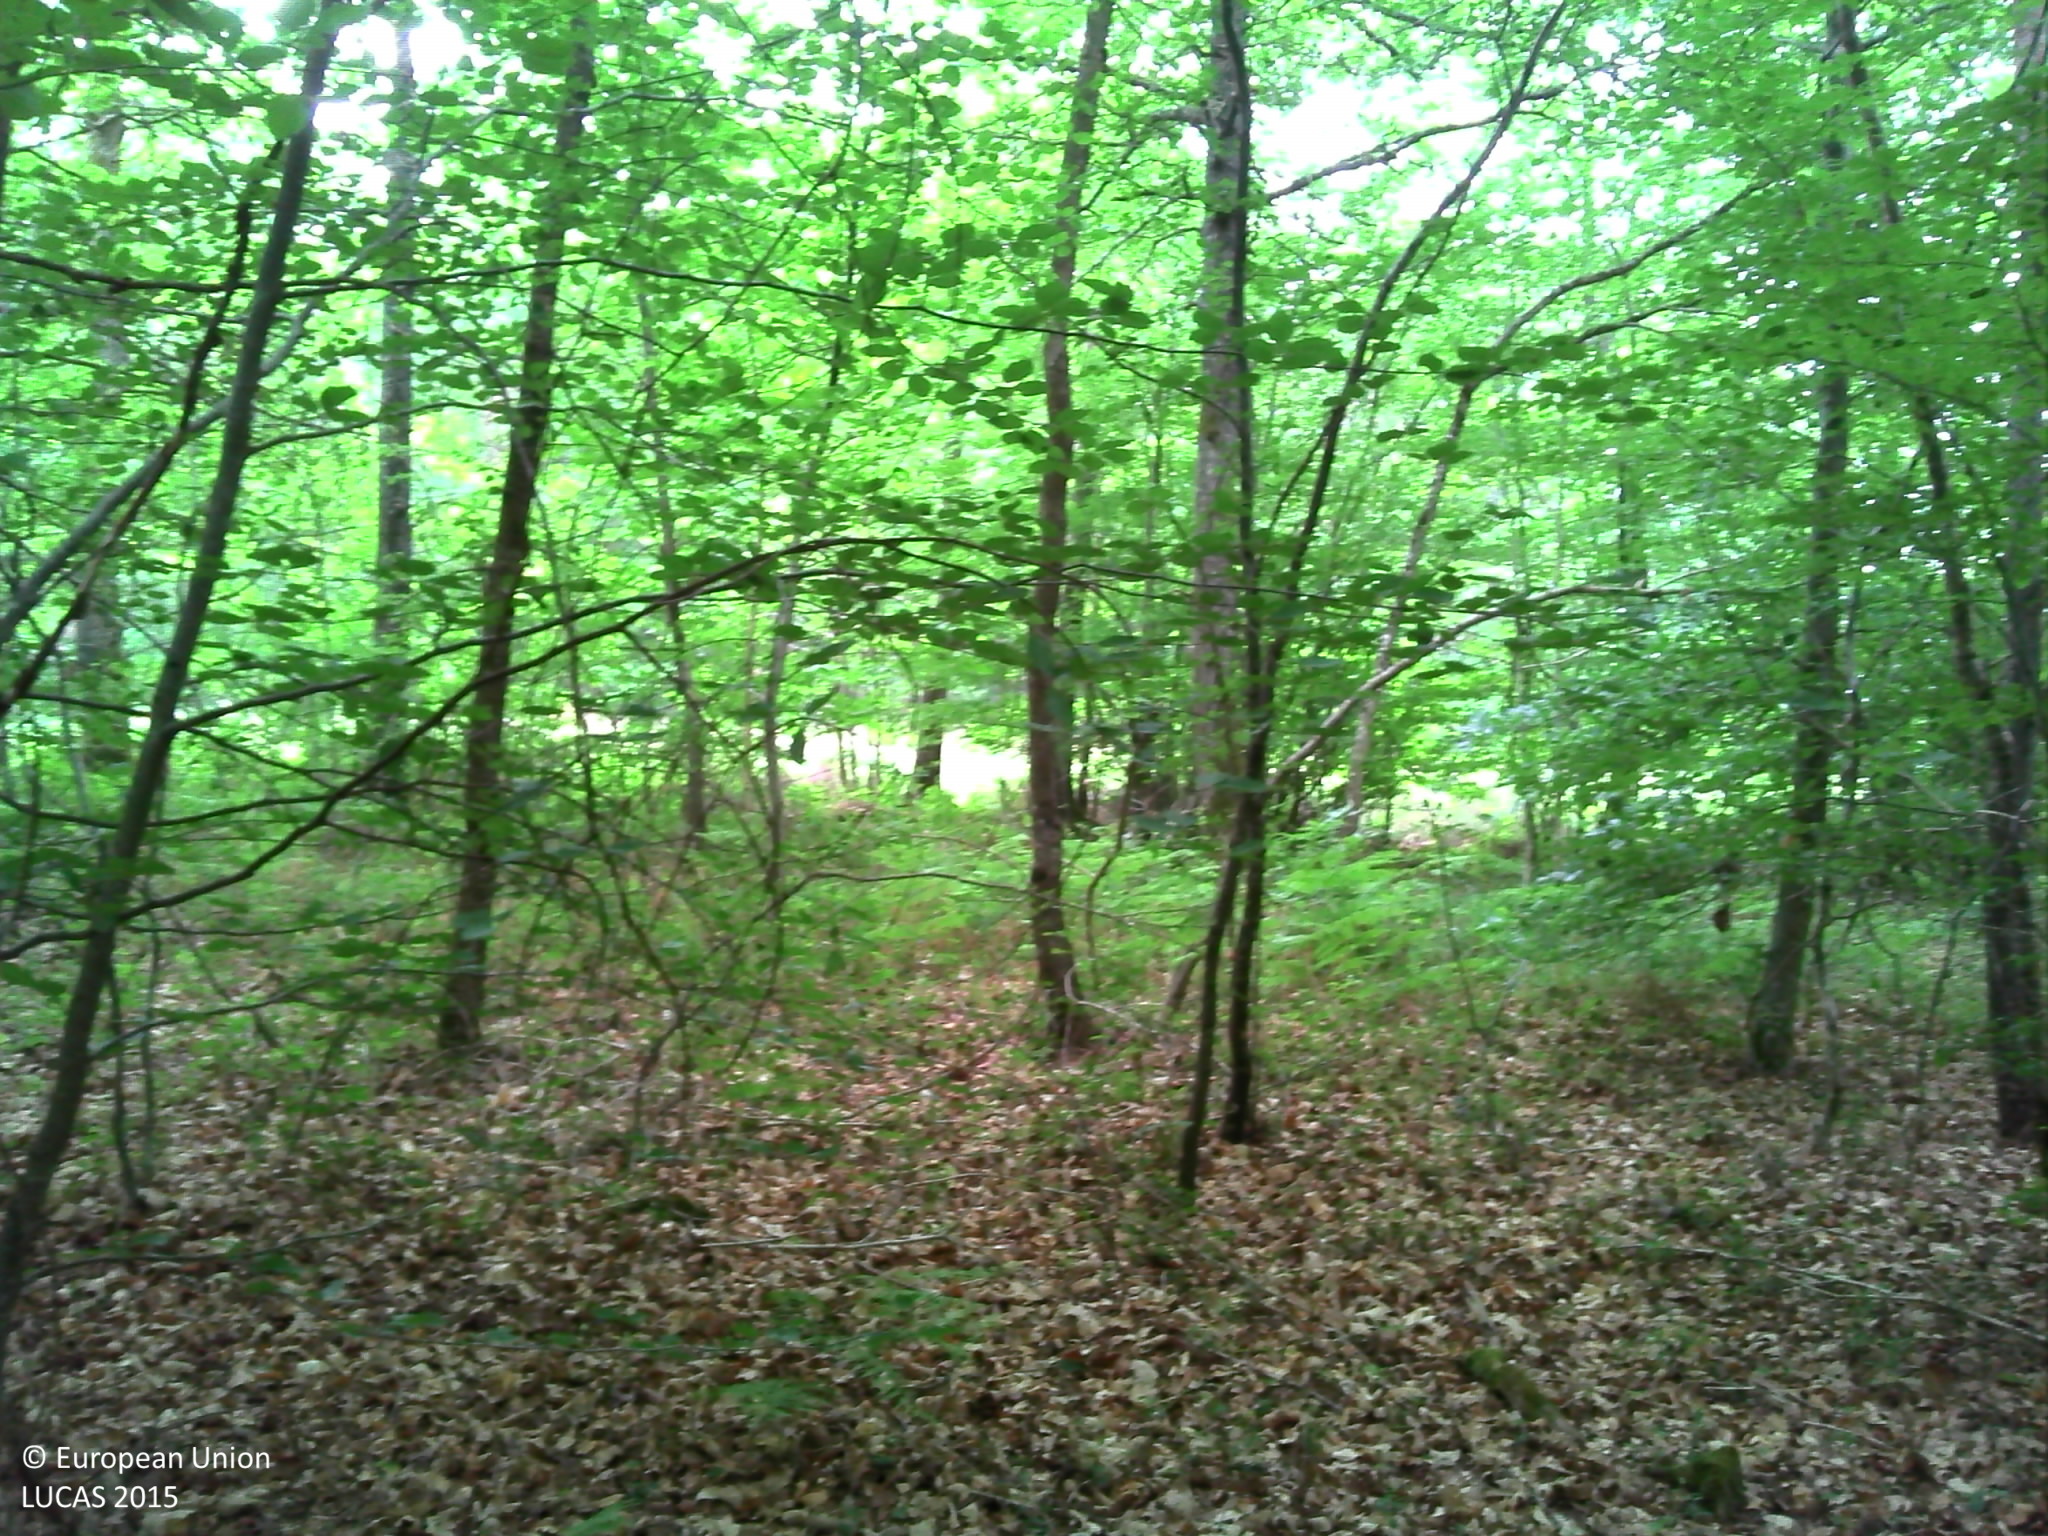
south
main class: Woodland
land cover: Broadleaved woodland
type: beech forest
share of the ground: > 75 %
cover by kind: broadleaved forest trees 90 %, shrubs 10 %
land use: Forestry
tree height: > 5 m
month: May
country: FR
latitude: 47.1358
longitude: 2.7559
